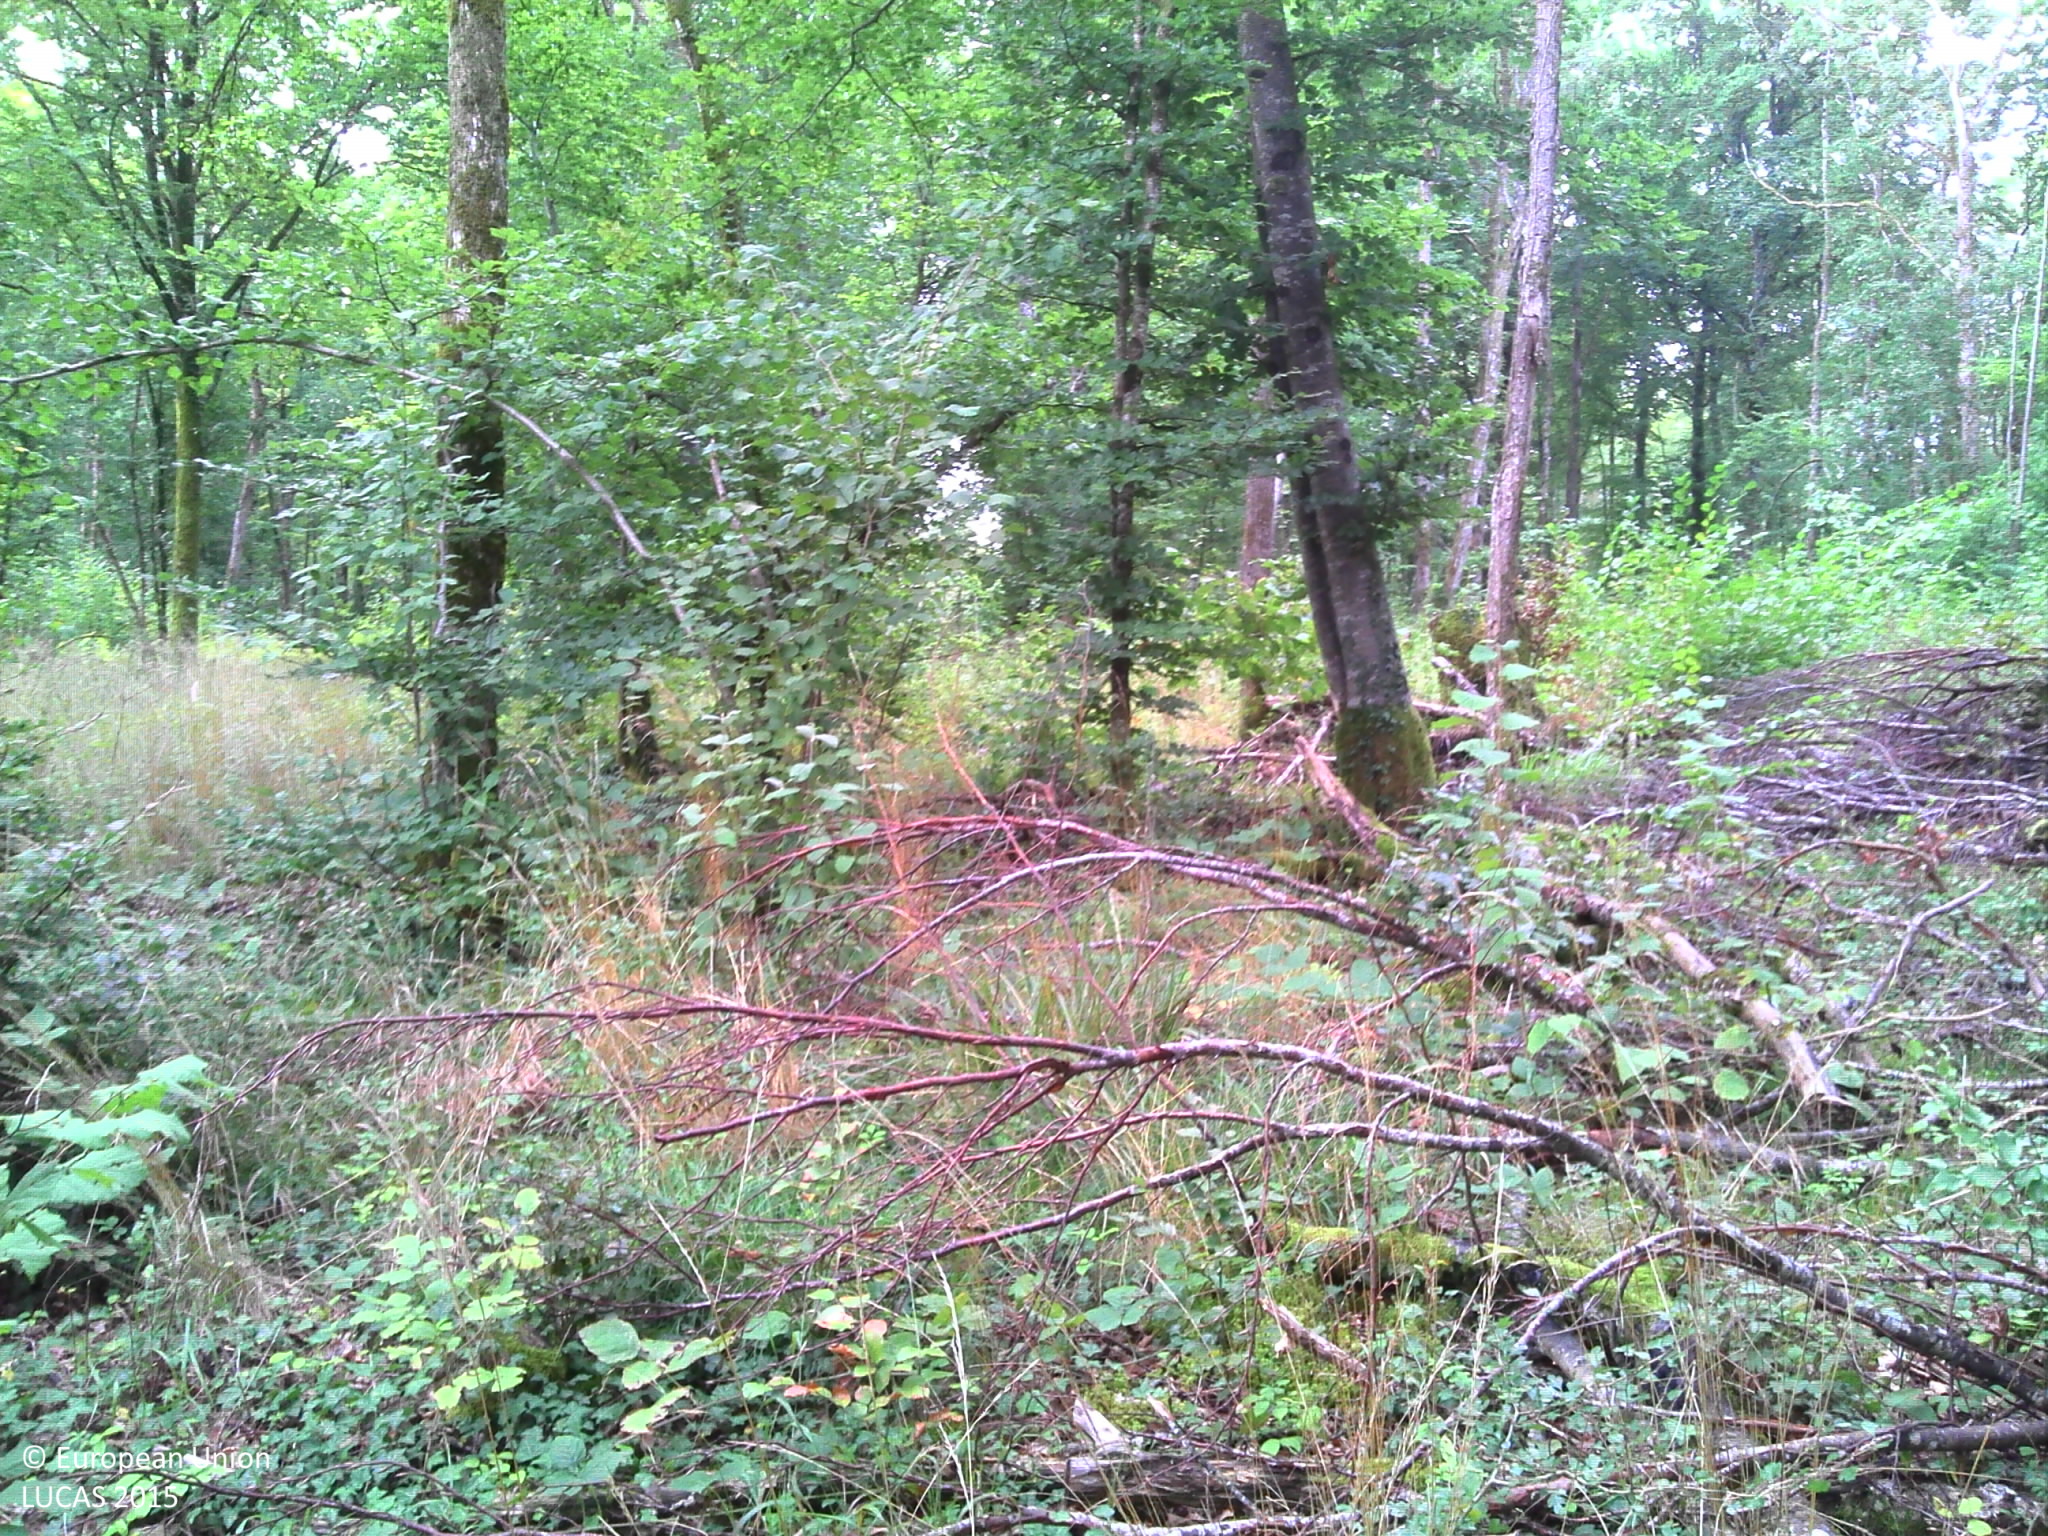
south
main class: Woodland
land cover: Broadleaved woodland
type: mesophytic deciduous forest
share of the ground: > 75 %
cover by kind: broadleaved forest trees 90 %, herbaceous plants 5 %, lichens and mosses 5 %
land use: Forestry
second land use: Amenities, museums, leisure
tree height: > 5 m
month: September
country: FR
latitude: 47.6343
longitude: 4.8489
